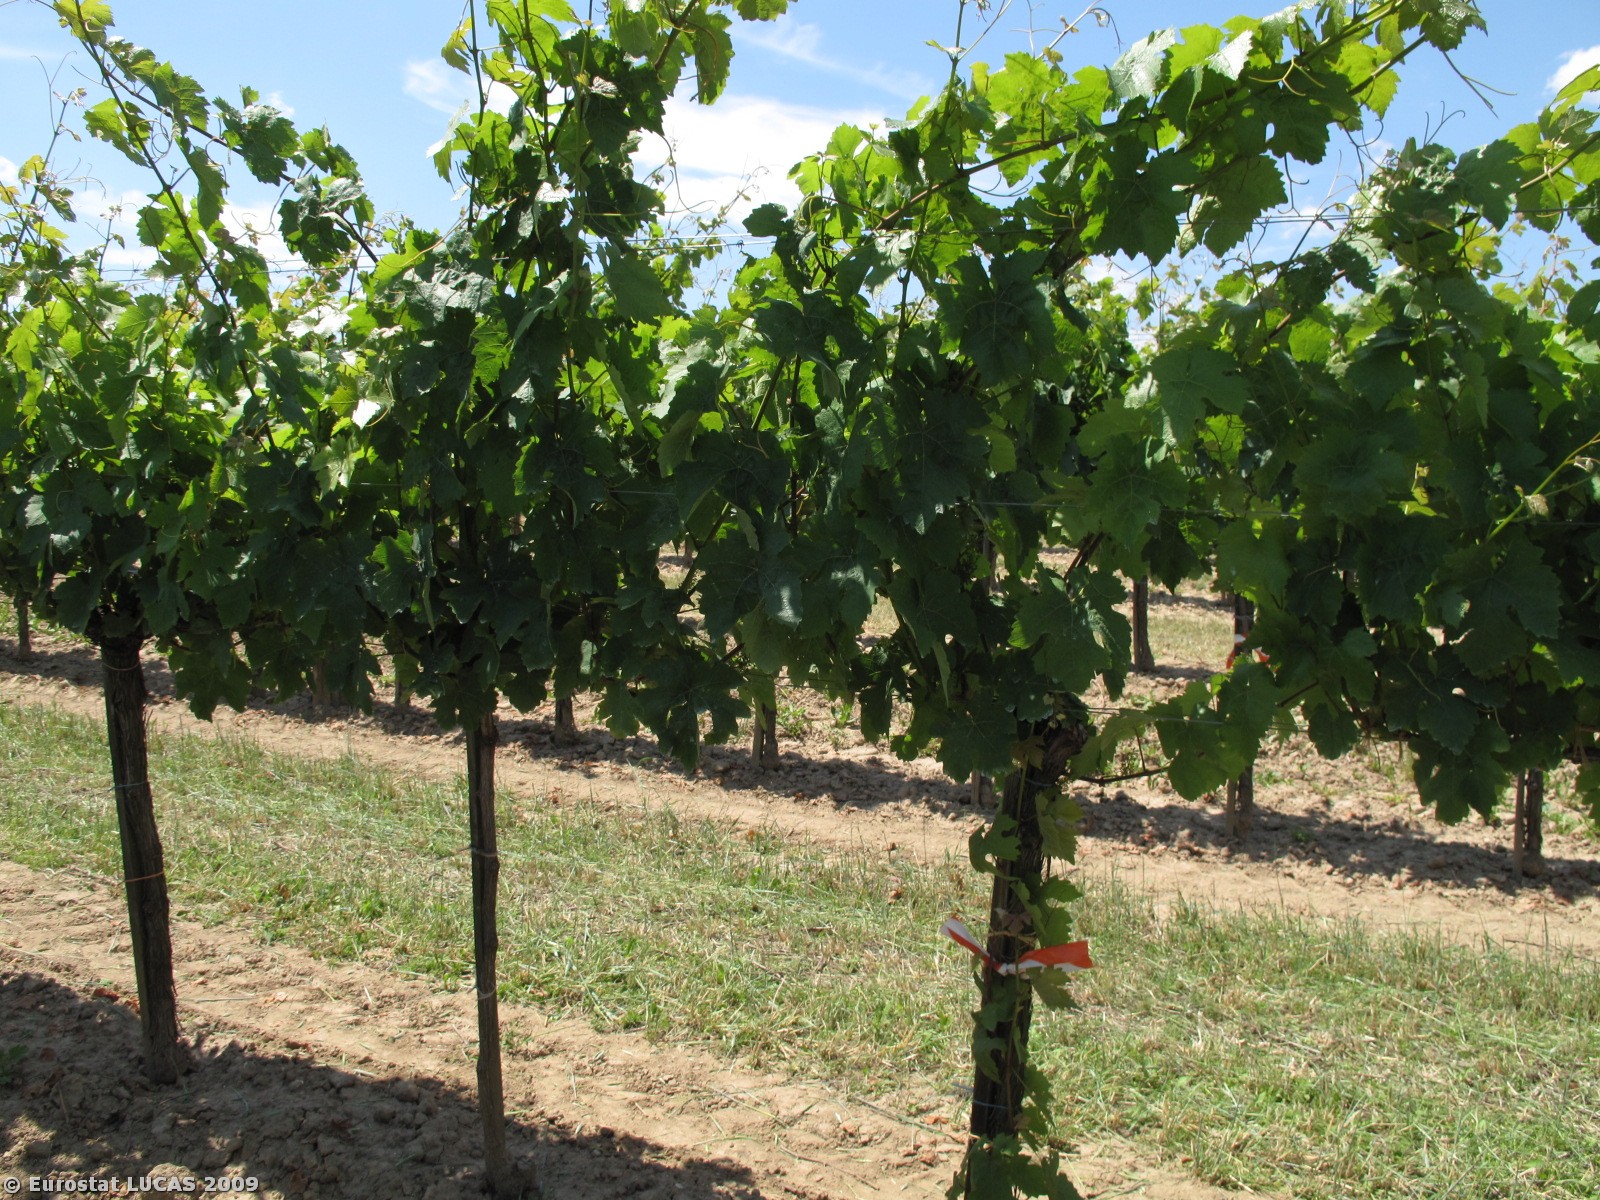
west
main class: Cropland
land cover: Vineyards
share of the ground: < 10 %
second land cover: Grassland with sparse tree/shrub cover
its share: 25 - 50 %
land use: Agriculture (excluding fallow land and kitchen gardens)
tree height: < 5 m
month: June
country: AT
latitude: 48.4811
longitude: 15.8888
